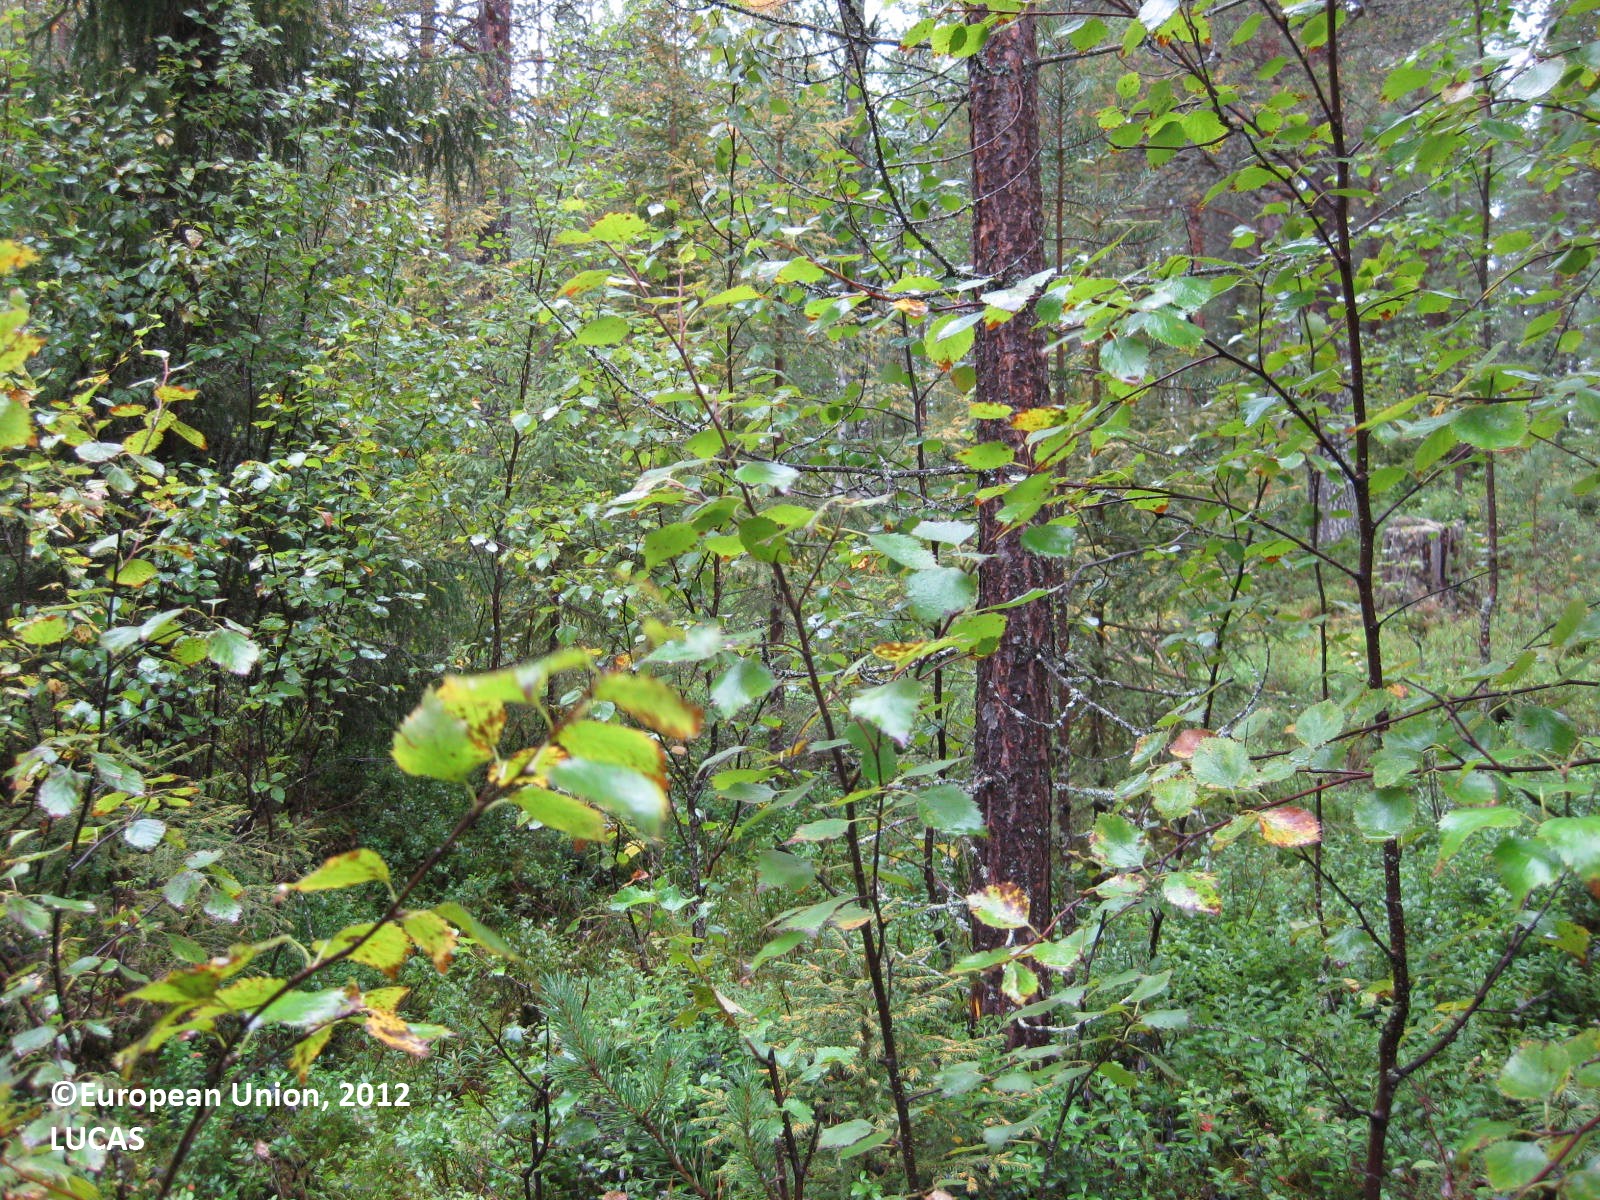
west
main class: Woodland
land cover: Pine dominated mixed woodland
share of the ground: > 75 %
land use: Forestry
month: August
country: FI
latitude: 66.1408
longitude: 28.7946
